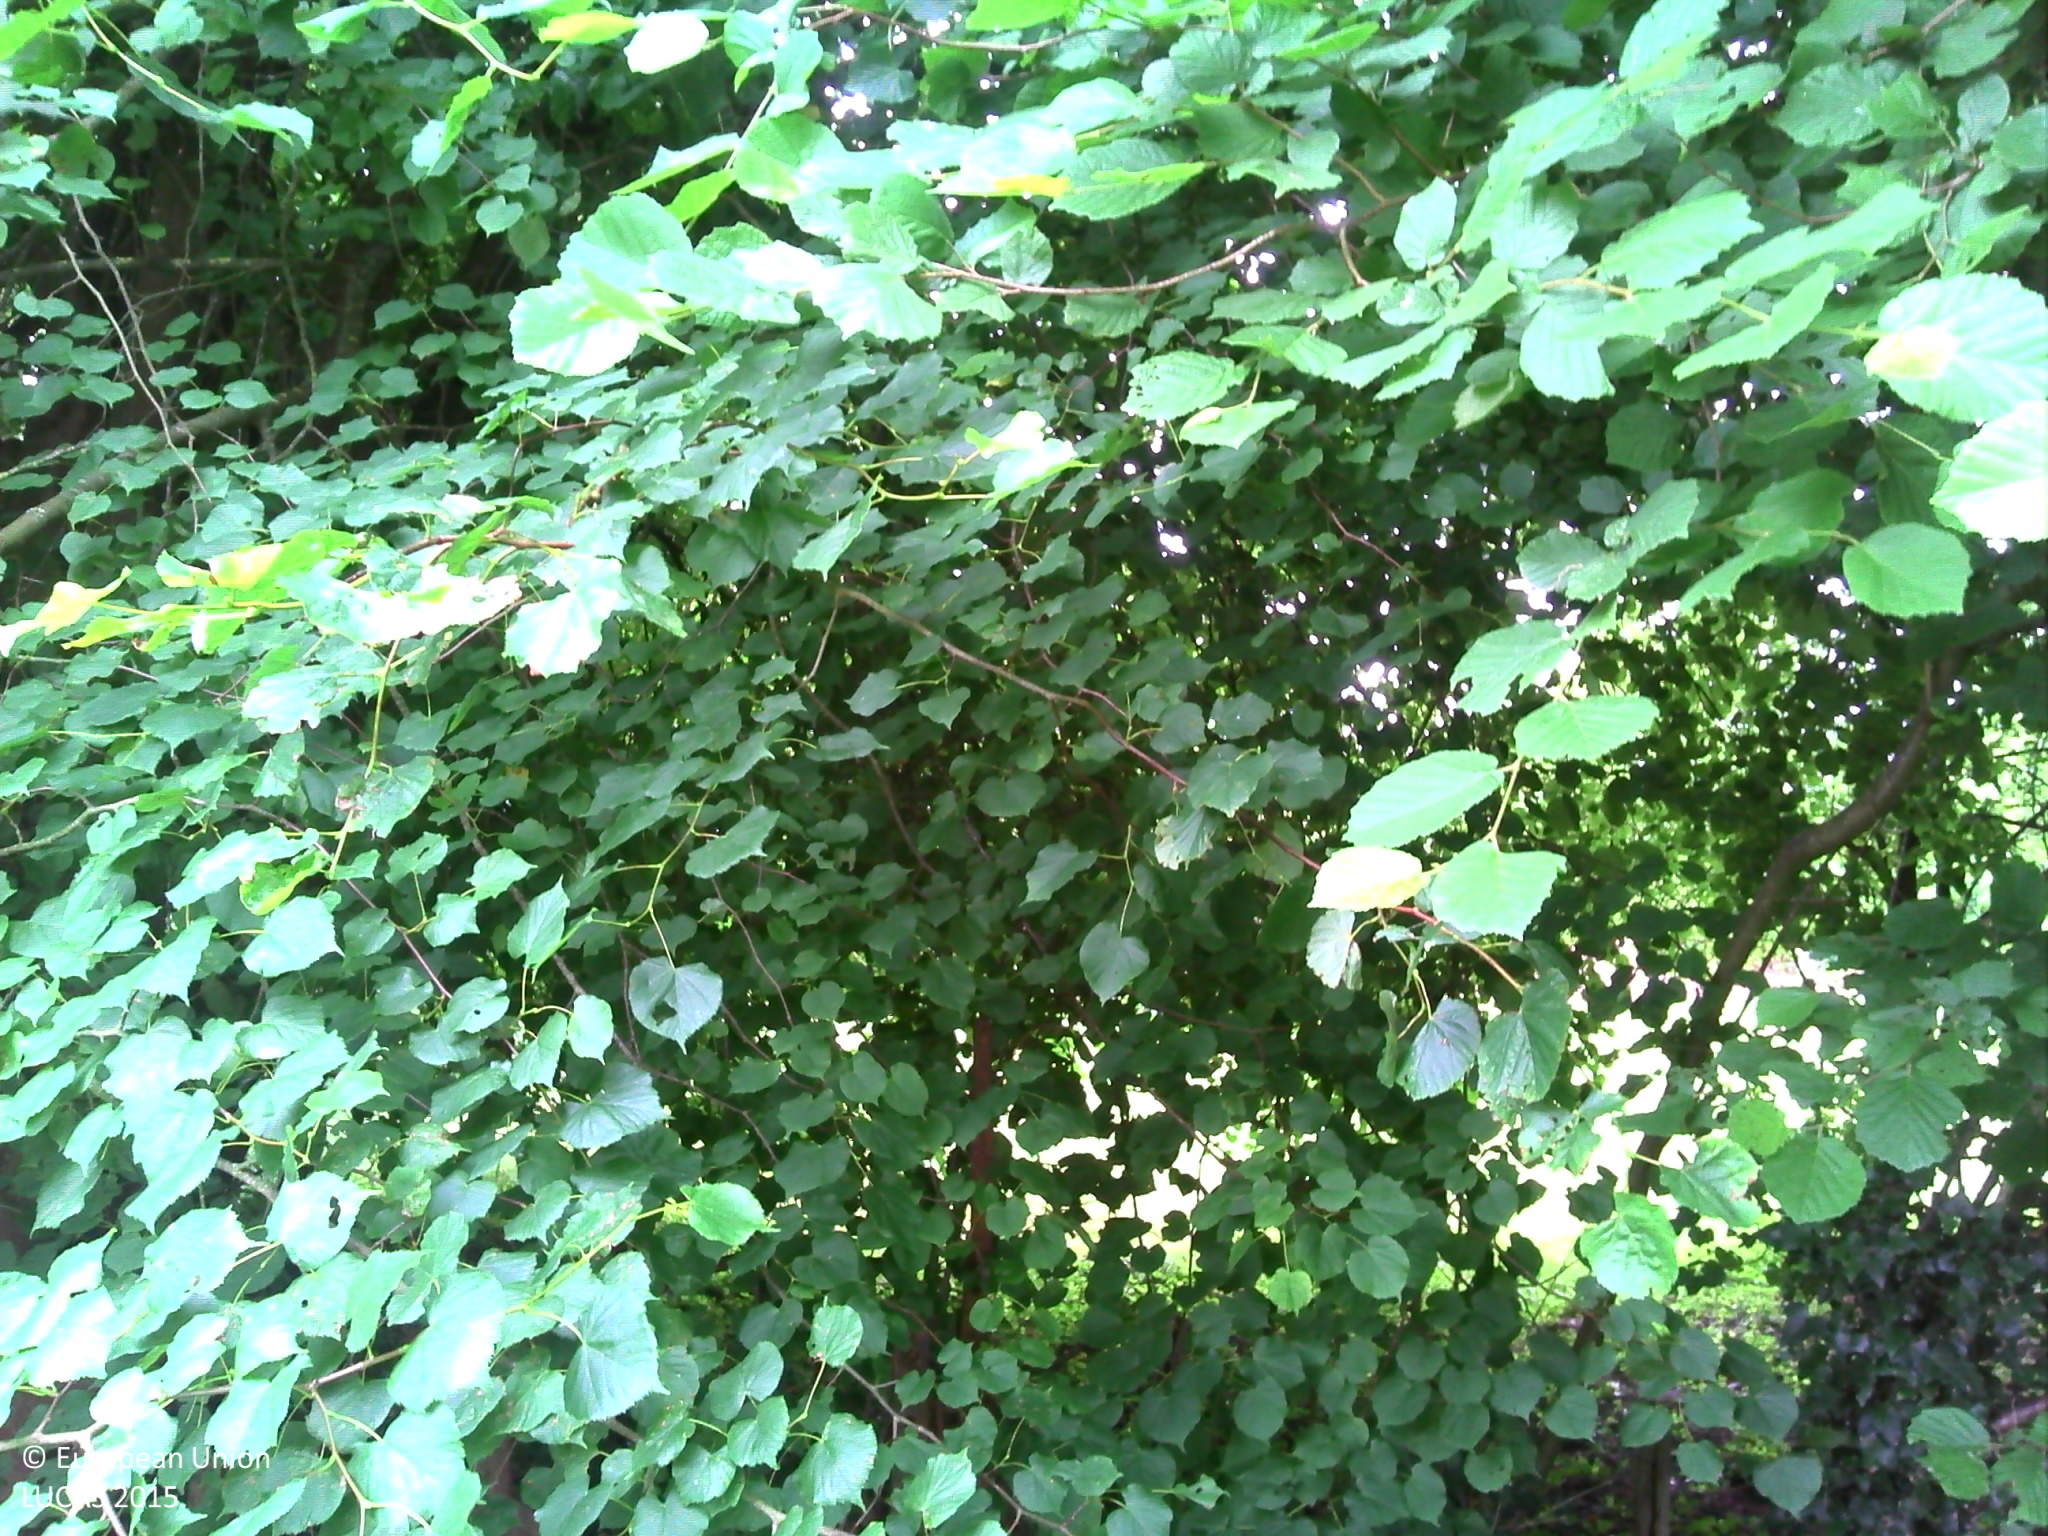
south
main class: Grassland
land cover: Grassland with sparse tree/shrub cover
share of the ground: > 75 %
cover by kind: herbaceous plants 95 %, broadleaved forest trees 5 %
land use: Agriculture (excluding fallow land and kitchen gardens)
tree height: > 5 m
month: June
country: FR
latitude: 48.0417
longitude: 0.2225
